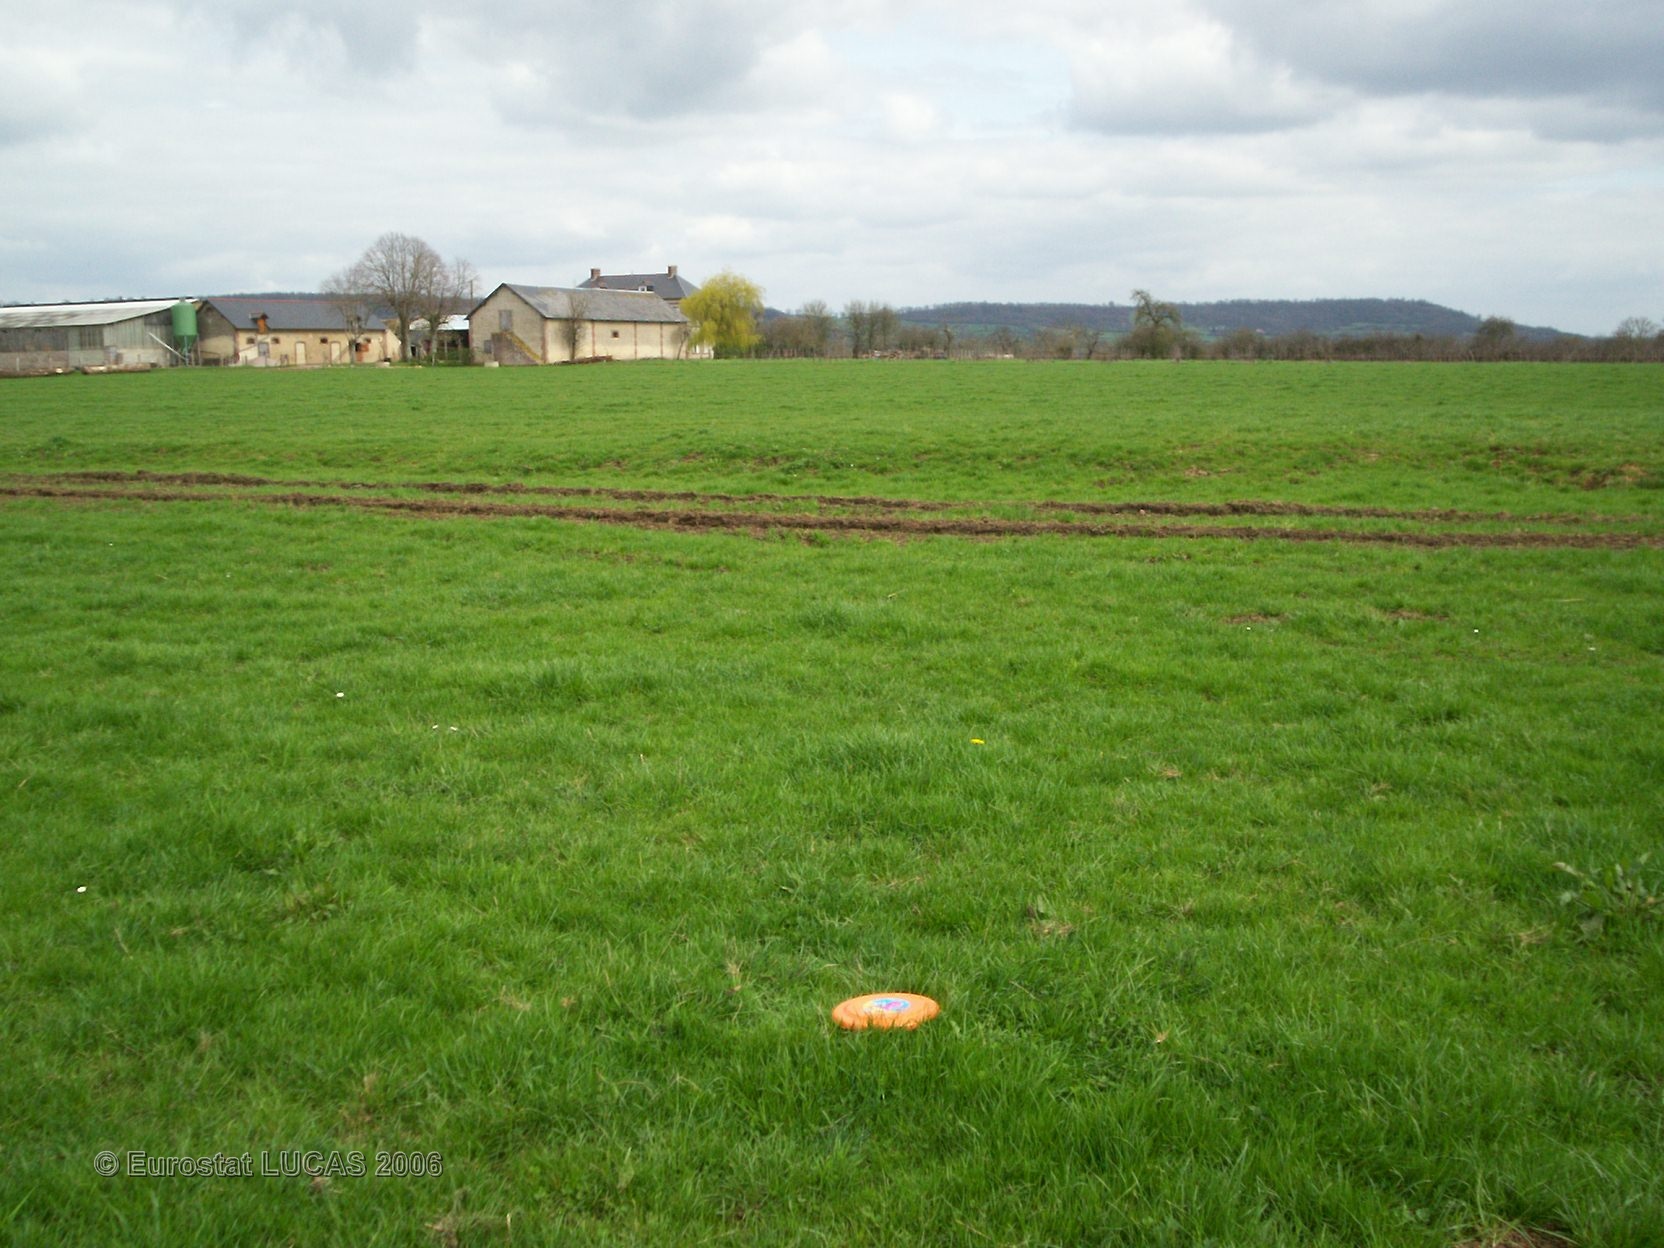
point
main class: Grassland
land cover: Grassland without tree/shrub cover
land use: Agriculture (excluding fallow land and kitchen gardens)
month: April
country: FR
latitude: 48.8455
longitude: 0.0912
